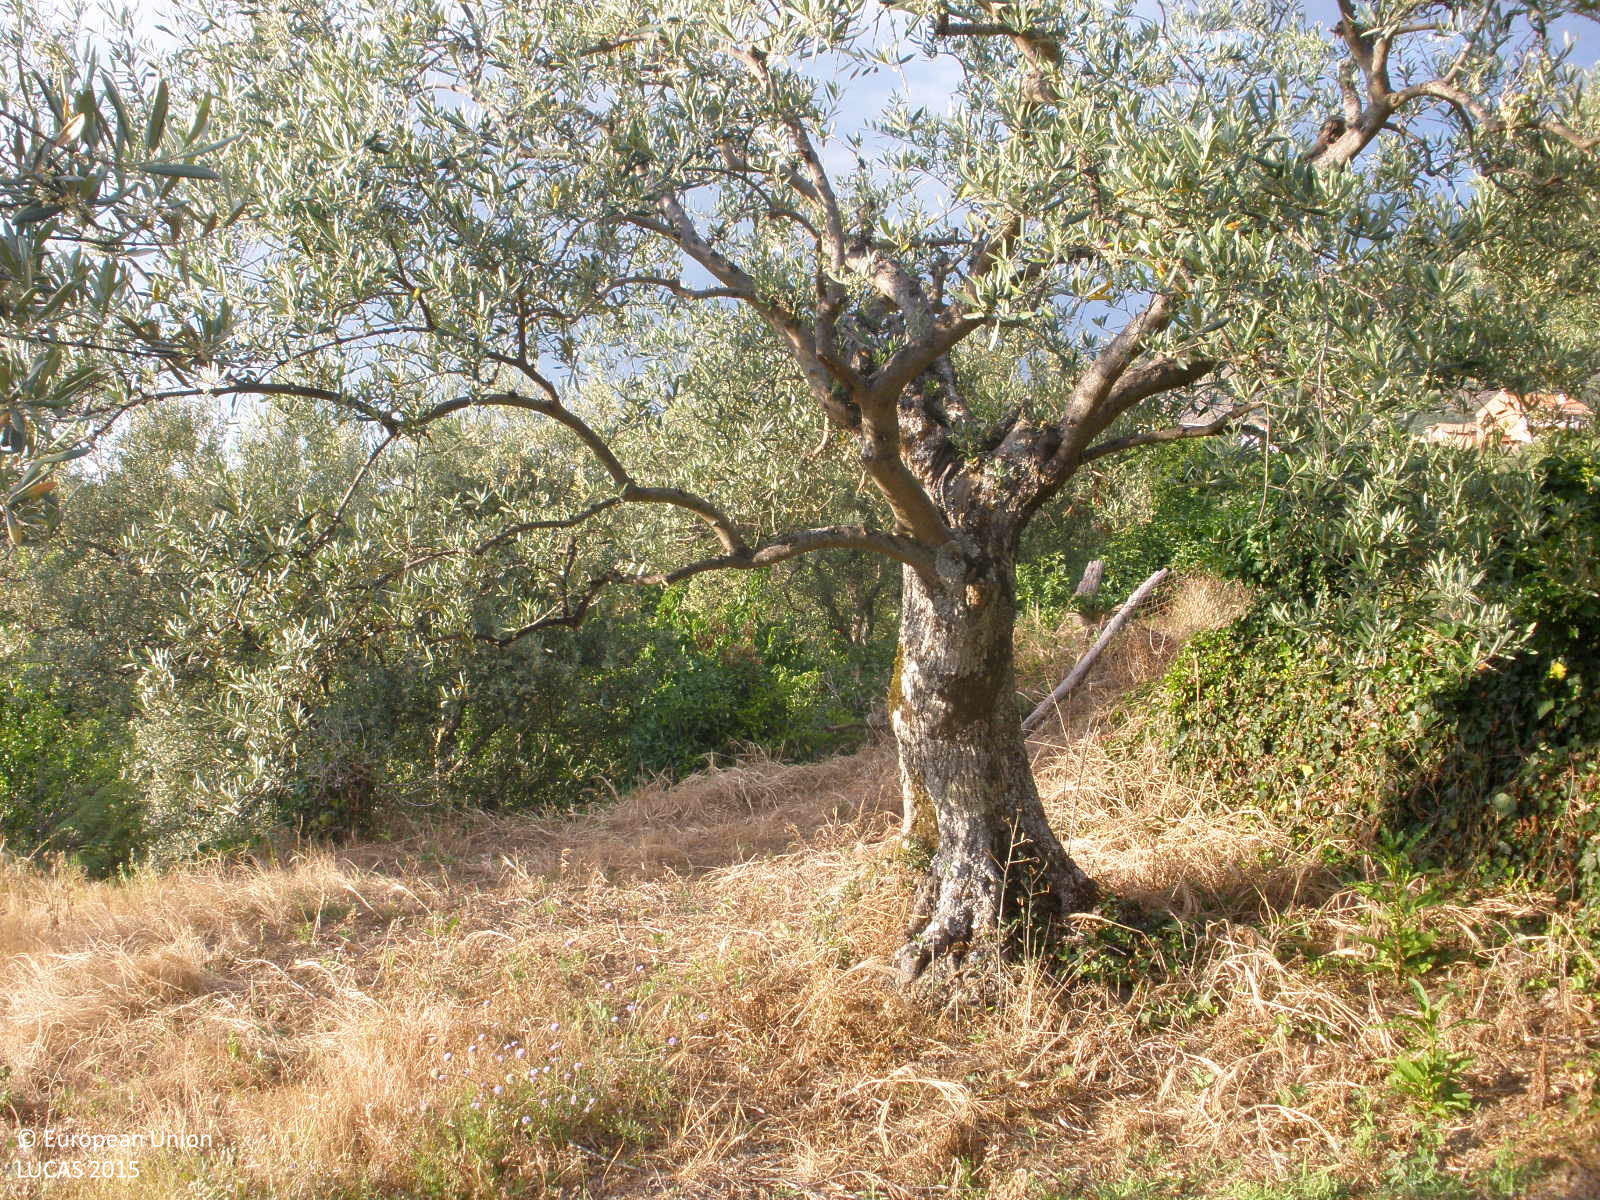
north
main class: Cropland
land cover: Olive groves
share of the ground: 25 - 50 %
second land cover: Grassland without tree/shrub cover
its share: > 75 %
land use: Agriculture (excluding fallow land and kitchen gardens)
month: May
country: ES
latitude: 40.2013
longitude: -5.9666
